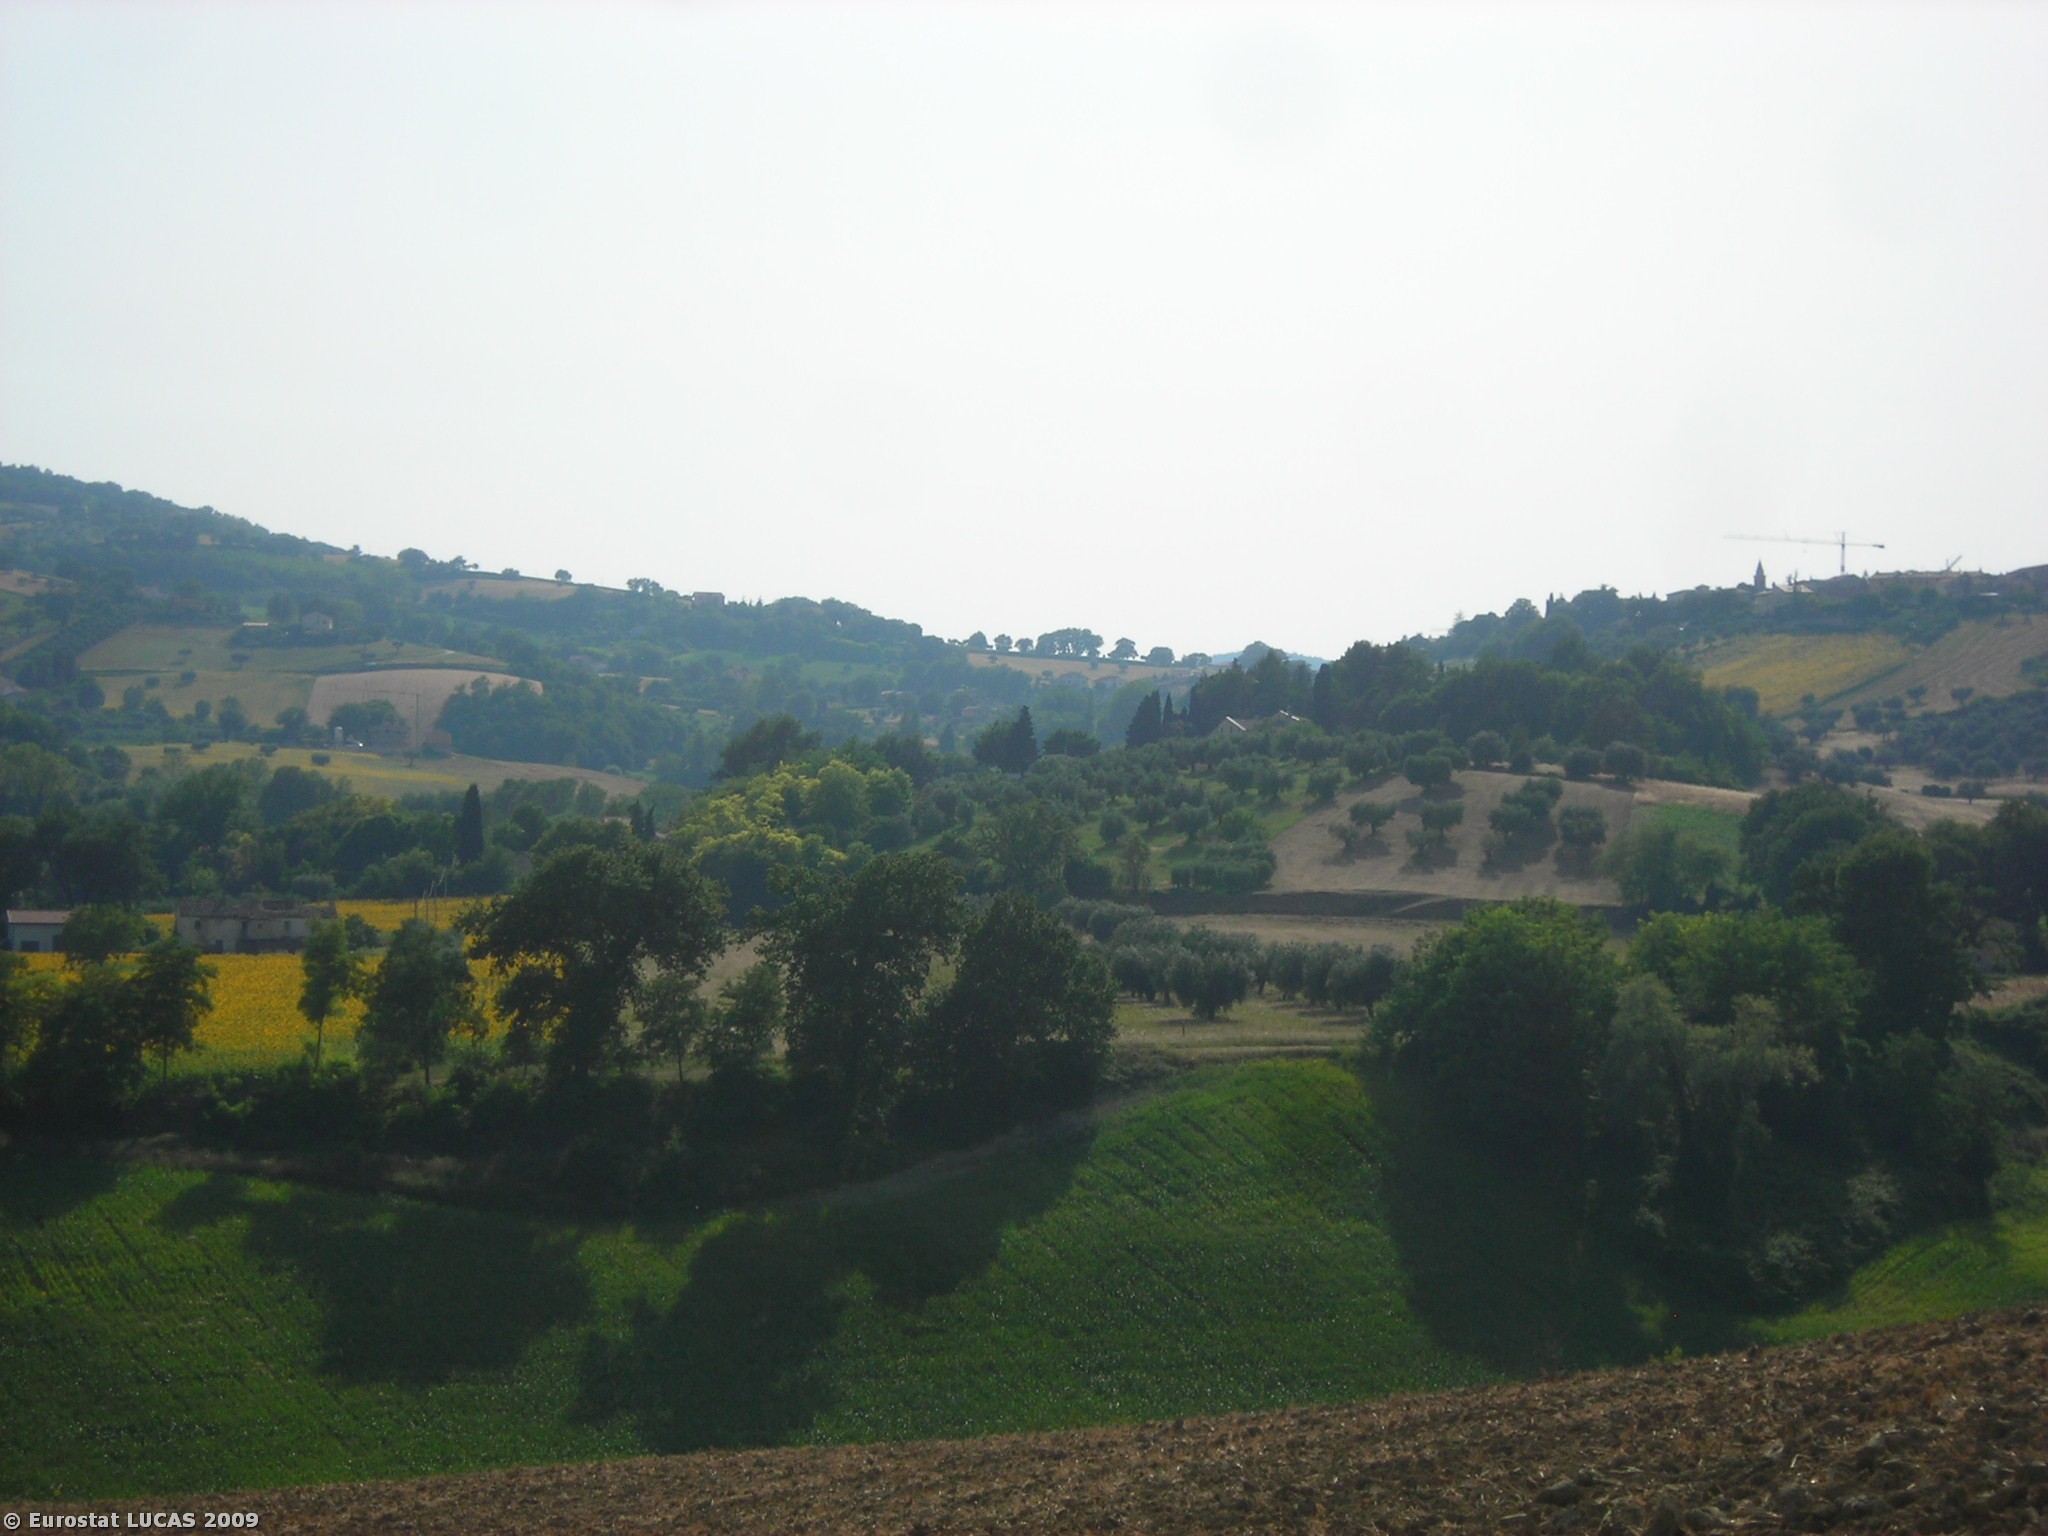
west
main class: Cropland
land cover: Barley
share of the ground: < 10 %
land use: Agriculture (excluding fallow land and kitchen gardens)
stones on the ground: < 10 %
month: July
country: IT
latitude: 43.3972
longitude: 13.2389
